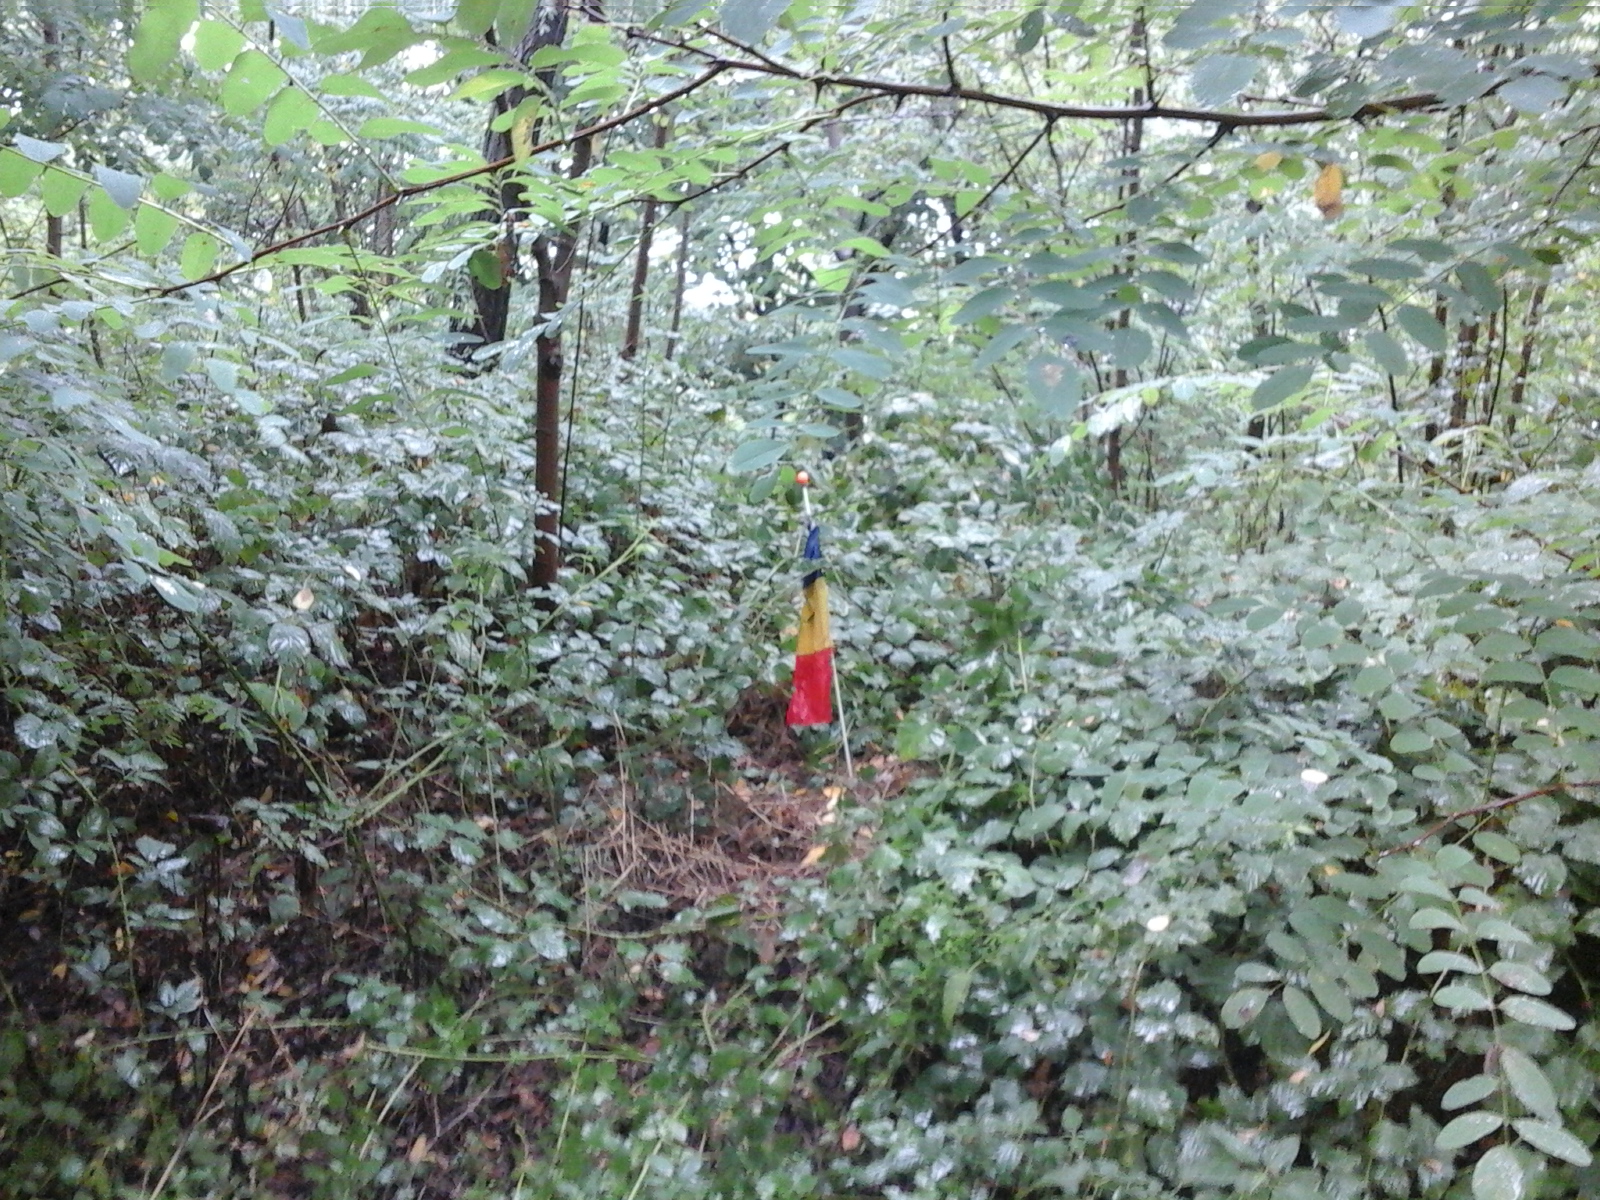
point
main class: Woodland
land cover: Broadleaved woodland
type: exotic forest
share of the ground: > 75 %
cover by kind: broadleaved forest trees 100 %
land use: Forestry
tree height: > 5 m
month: September
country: RO
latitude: 45.0192
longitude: 23.7544
